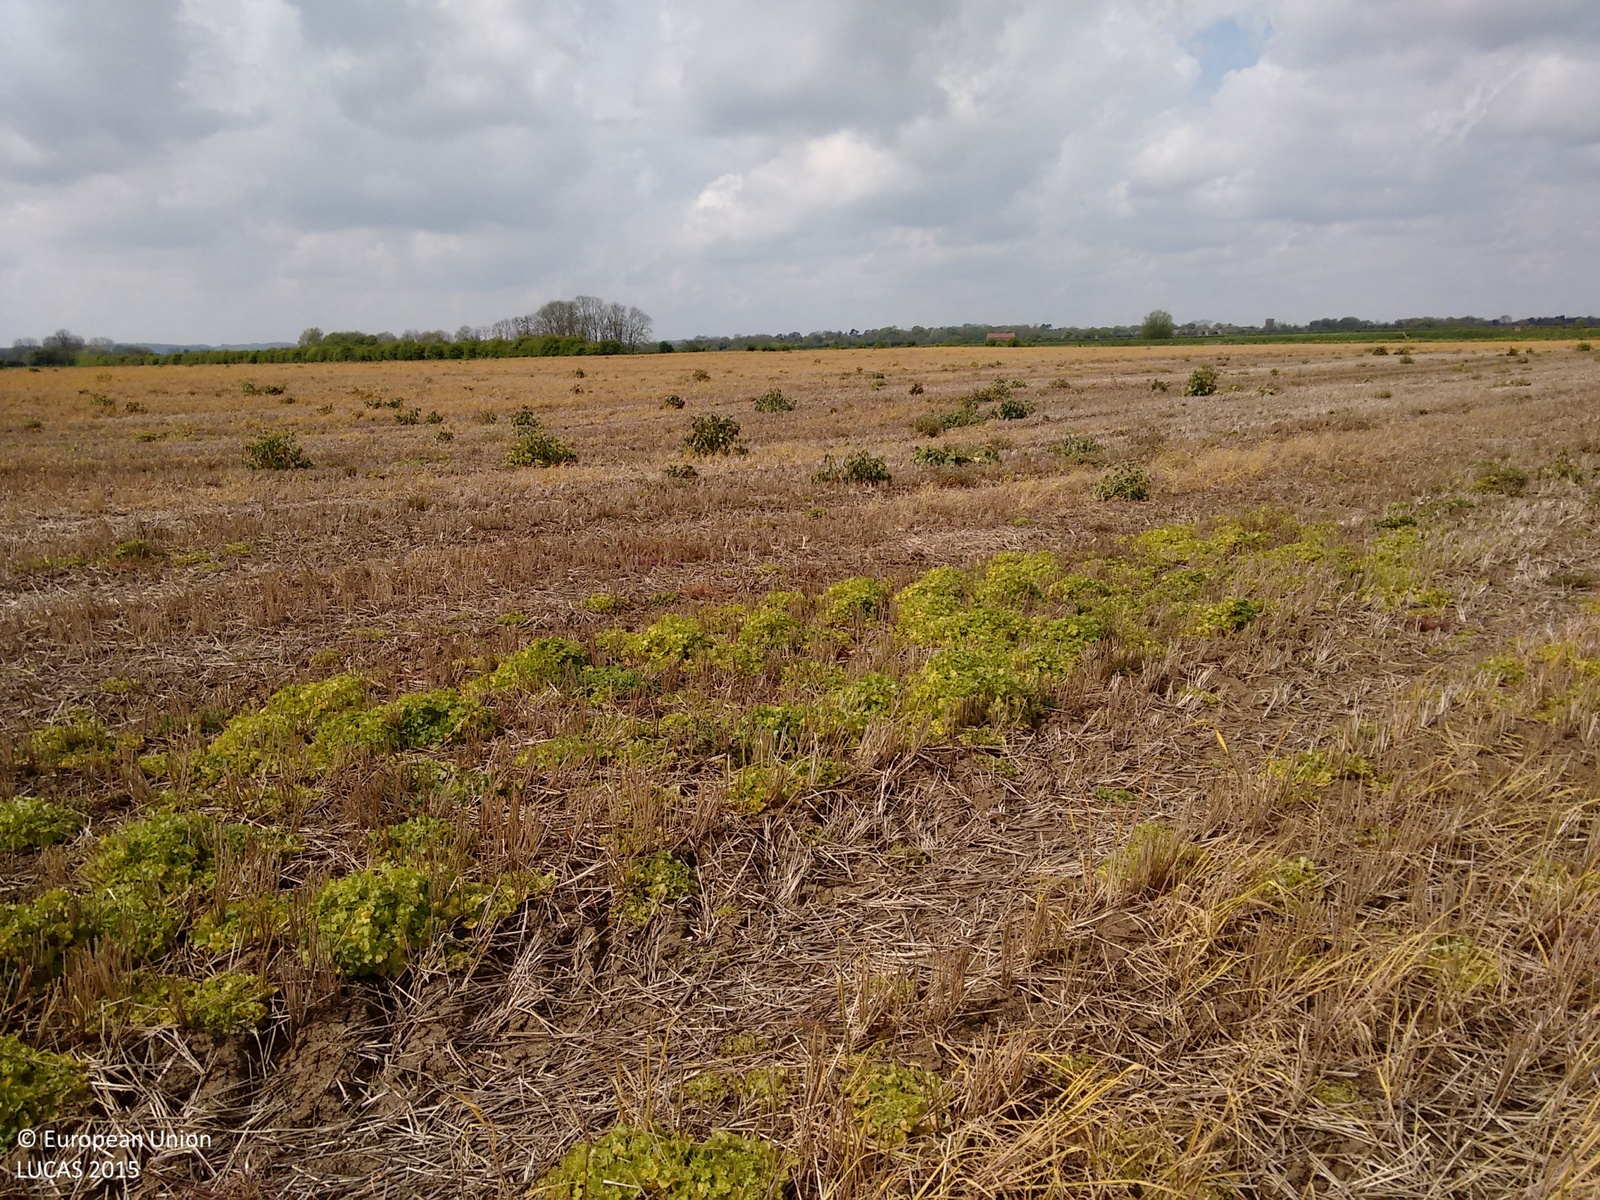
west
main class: Grassland
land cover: Spontaneously vegetated surfaces
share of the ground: 25 - 50 %
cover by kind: herbaceous plants 60 %, unconsolidated bare surface 40 %
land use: Agriculture (excluding fallow land and kitchen gardens)
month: May
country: GB
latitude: 53.3599
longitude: 0.1275
